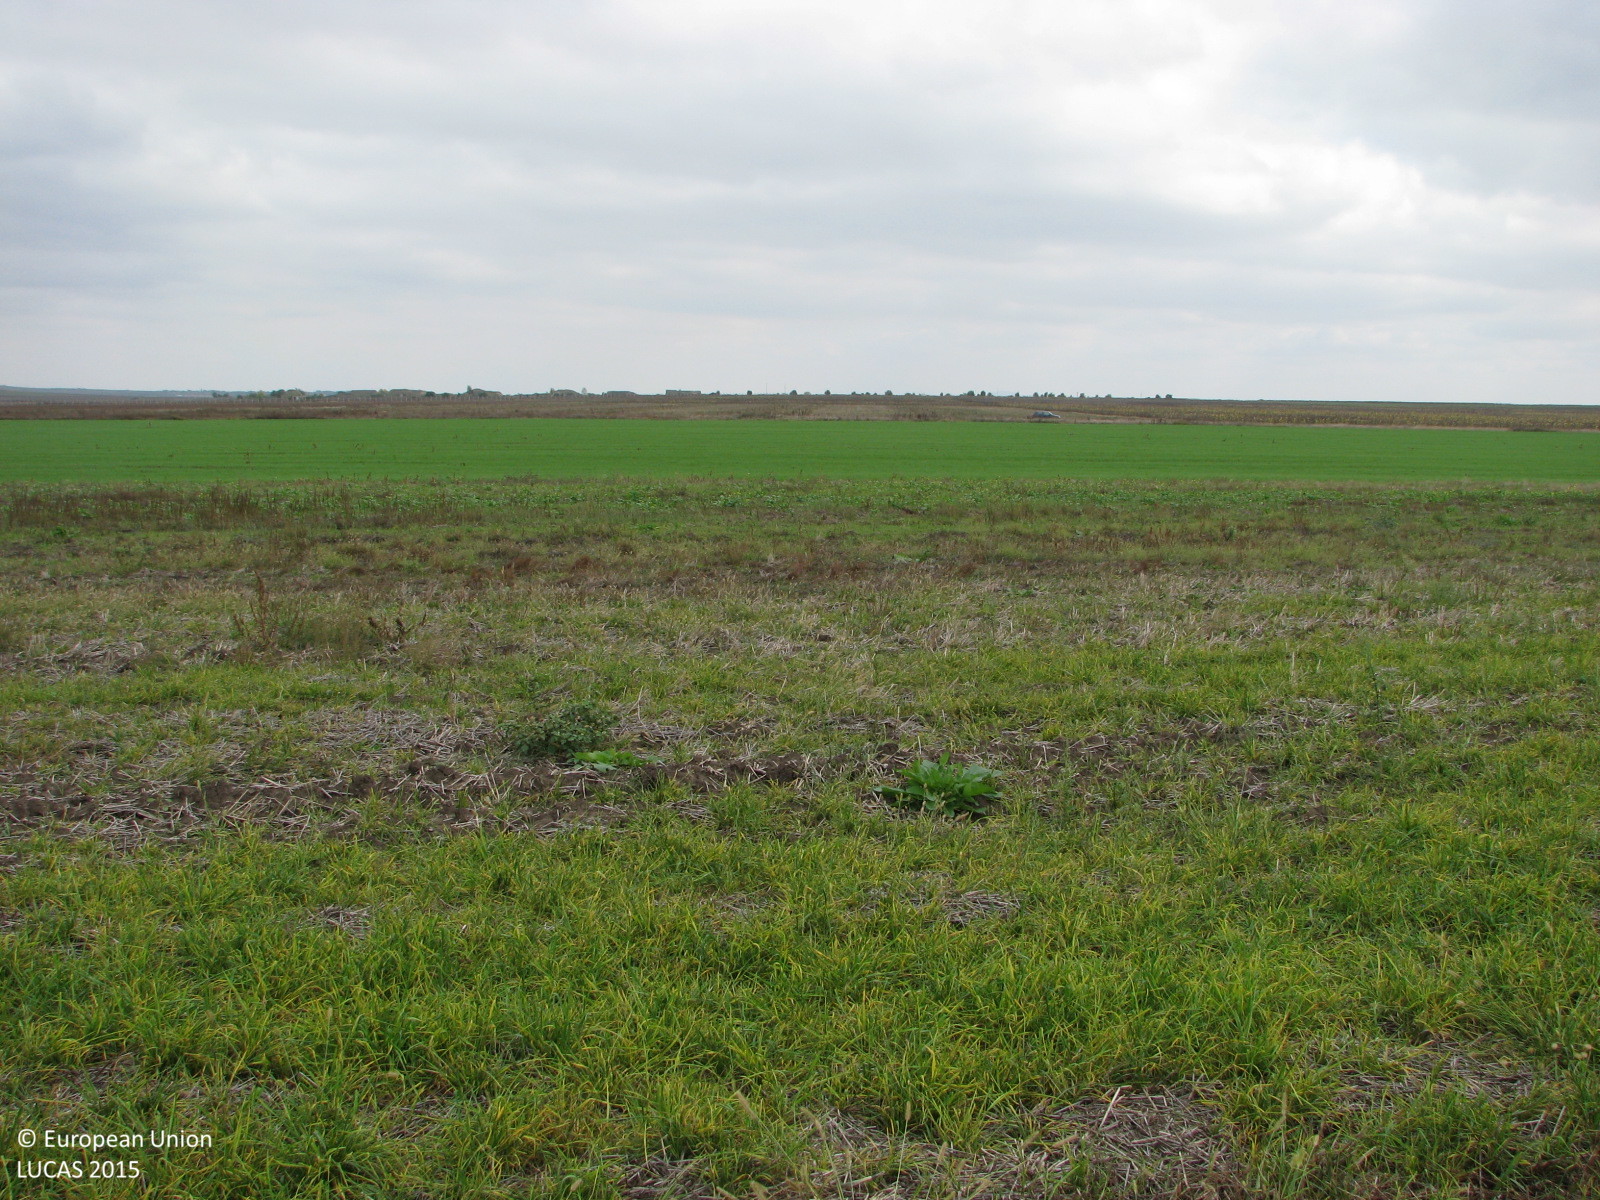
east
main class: Grassland
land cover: Spontaneously vegetated surfaces
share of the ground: > 75 %
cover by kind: herbaceous plants 100 %
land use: Agriculture (excluding fallow land and kitchen gardens)
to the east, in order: Spontaneously vegetated surfaces; Common wheat; Grassland without tree/shrub cover; Tracks; Grass margins; Sunflower
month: October
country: BG
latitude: 42.4595
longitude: 26.3221
